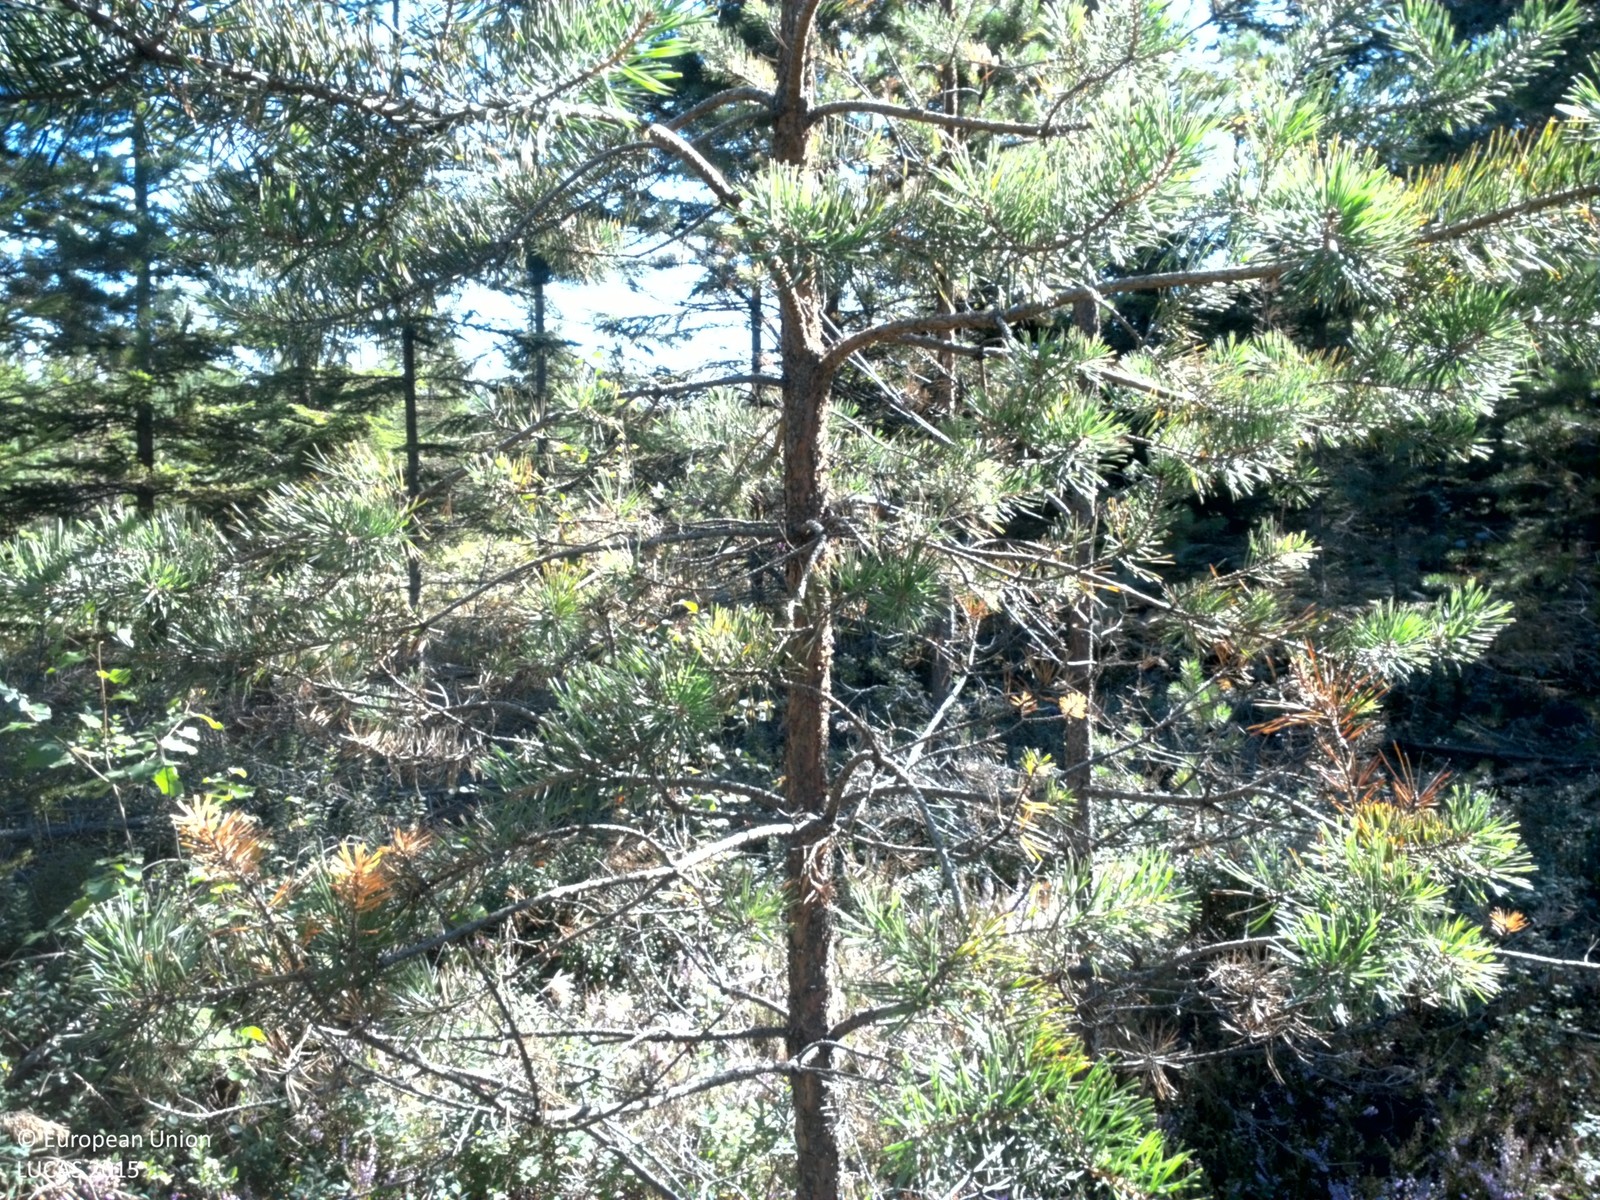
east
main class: Woodland
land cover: Pine dominated coniferous woodland
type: boreal forest
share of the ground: 50 - 75 %
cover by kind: coniferous forest trees 65 %, shrubs 30 %, herbaceous plants 5 %
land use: Forestry
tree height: < 5 m
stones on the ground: < 10 %
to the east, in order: Pine dominated coniferous woodland; Other coniferous woodland
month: August
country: SE
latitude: 59.6227
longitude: 15.9302
